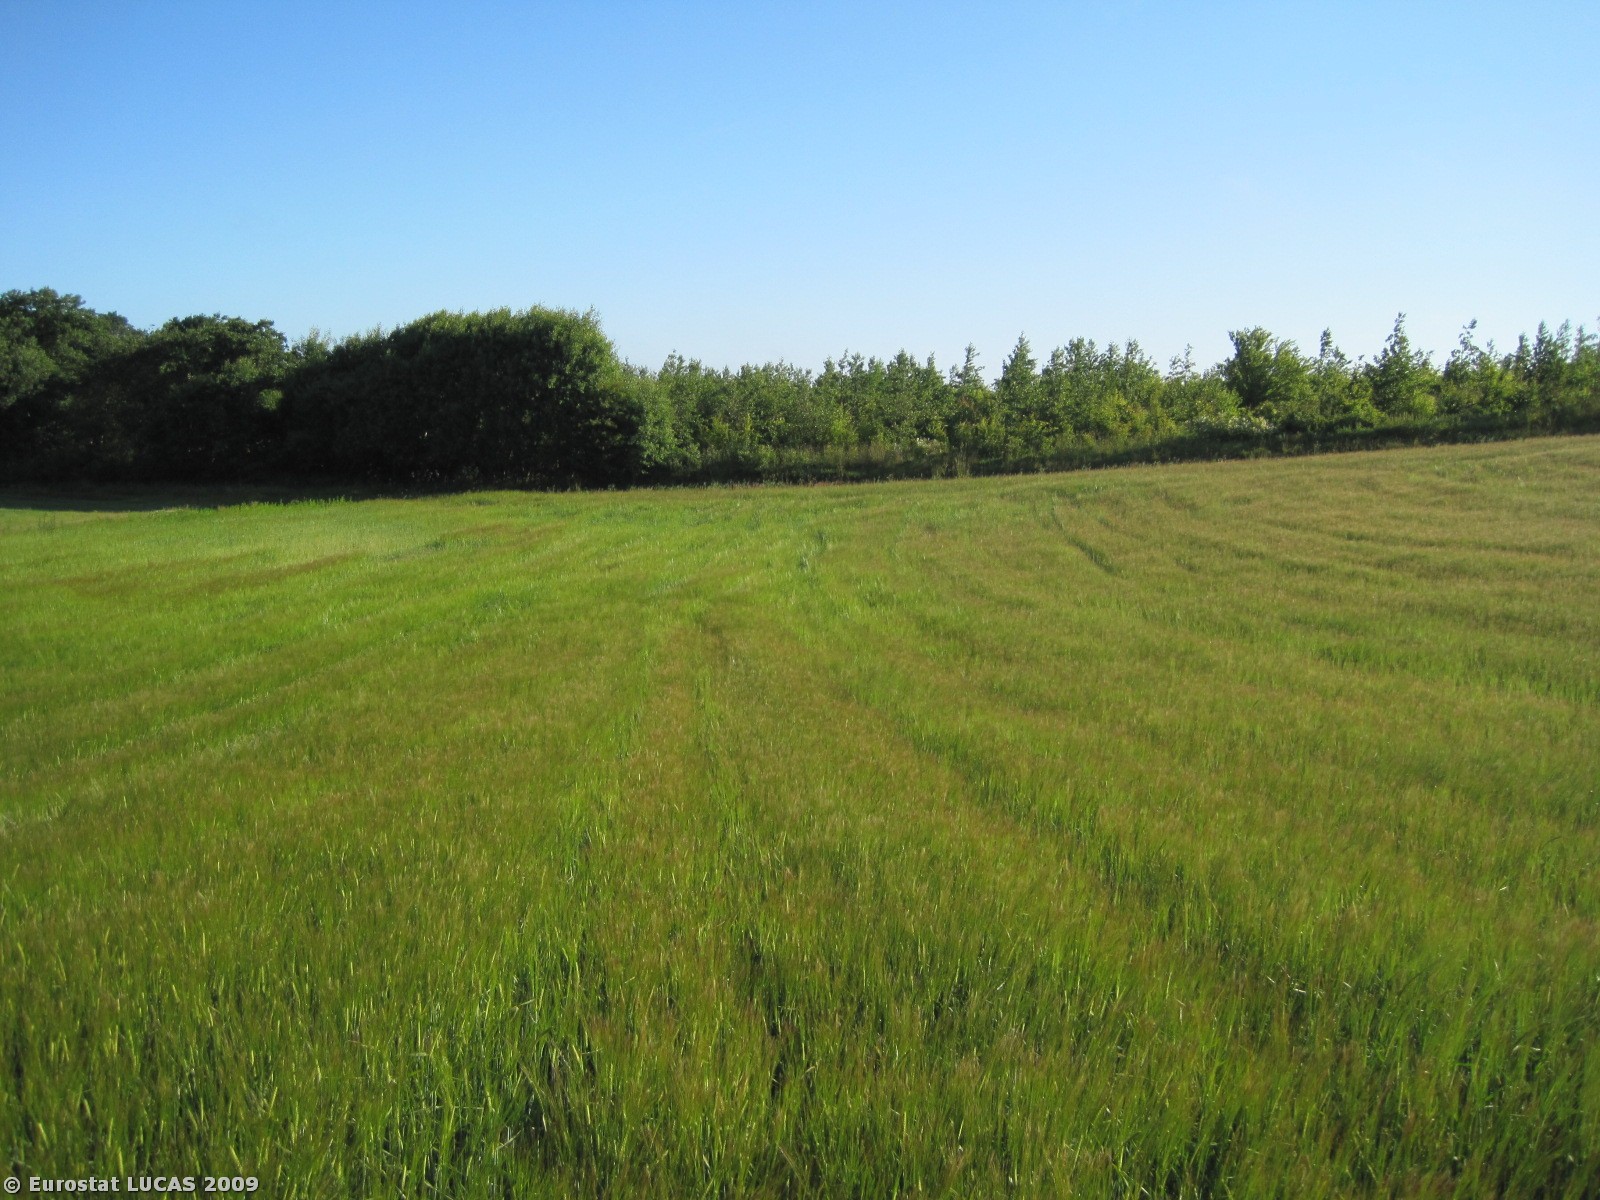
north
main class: Cropland
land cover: Barley
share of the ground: > 75 %
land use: Agriculture (excluding fallow land and kitchen gardens)
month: June
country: DK
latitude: 56.6167
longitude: 9.2026
